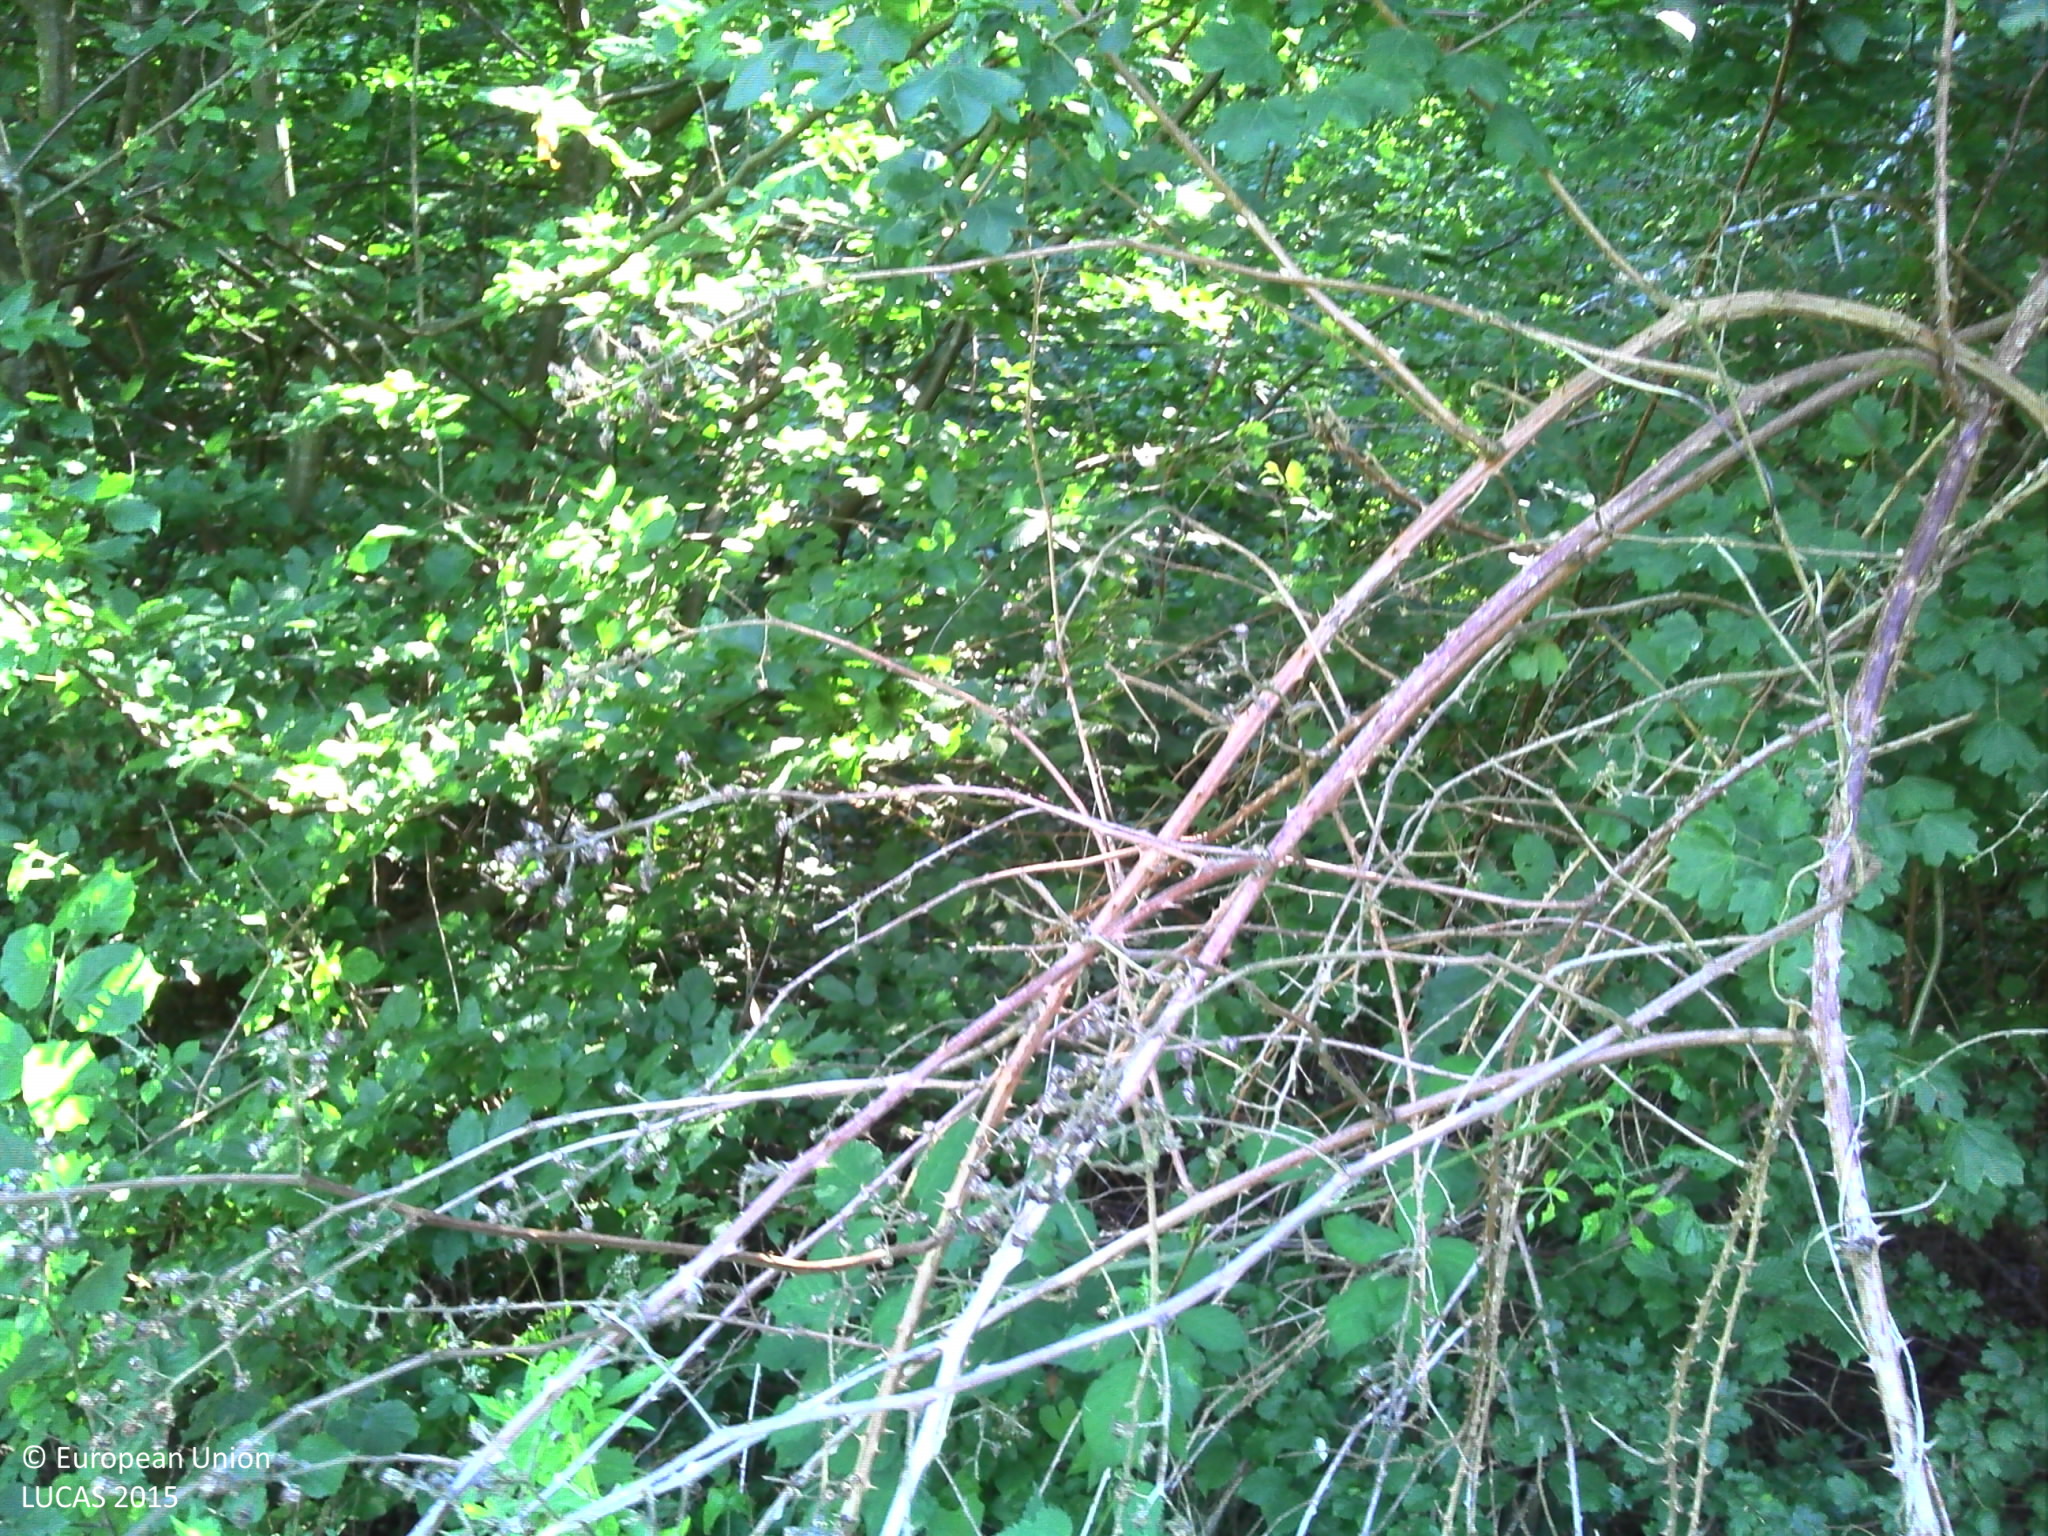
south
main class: Grassland
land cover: Grassland without tree/shrub cover
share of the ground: > 75 %
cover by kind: herbaceous plants 100 %
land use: Agriculture (excluding fallow land and kitchen gardens)
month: July
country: FR
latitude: 46.9511
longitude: 3.5464
